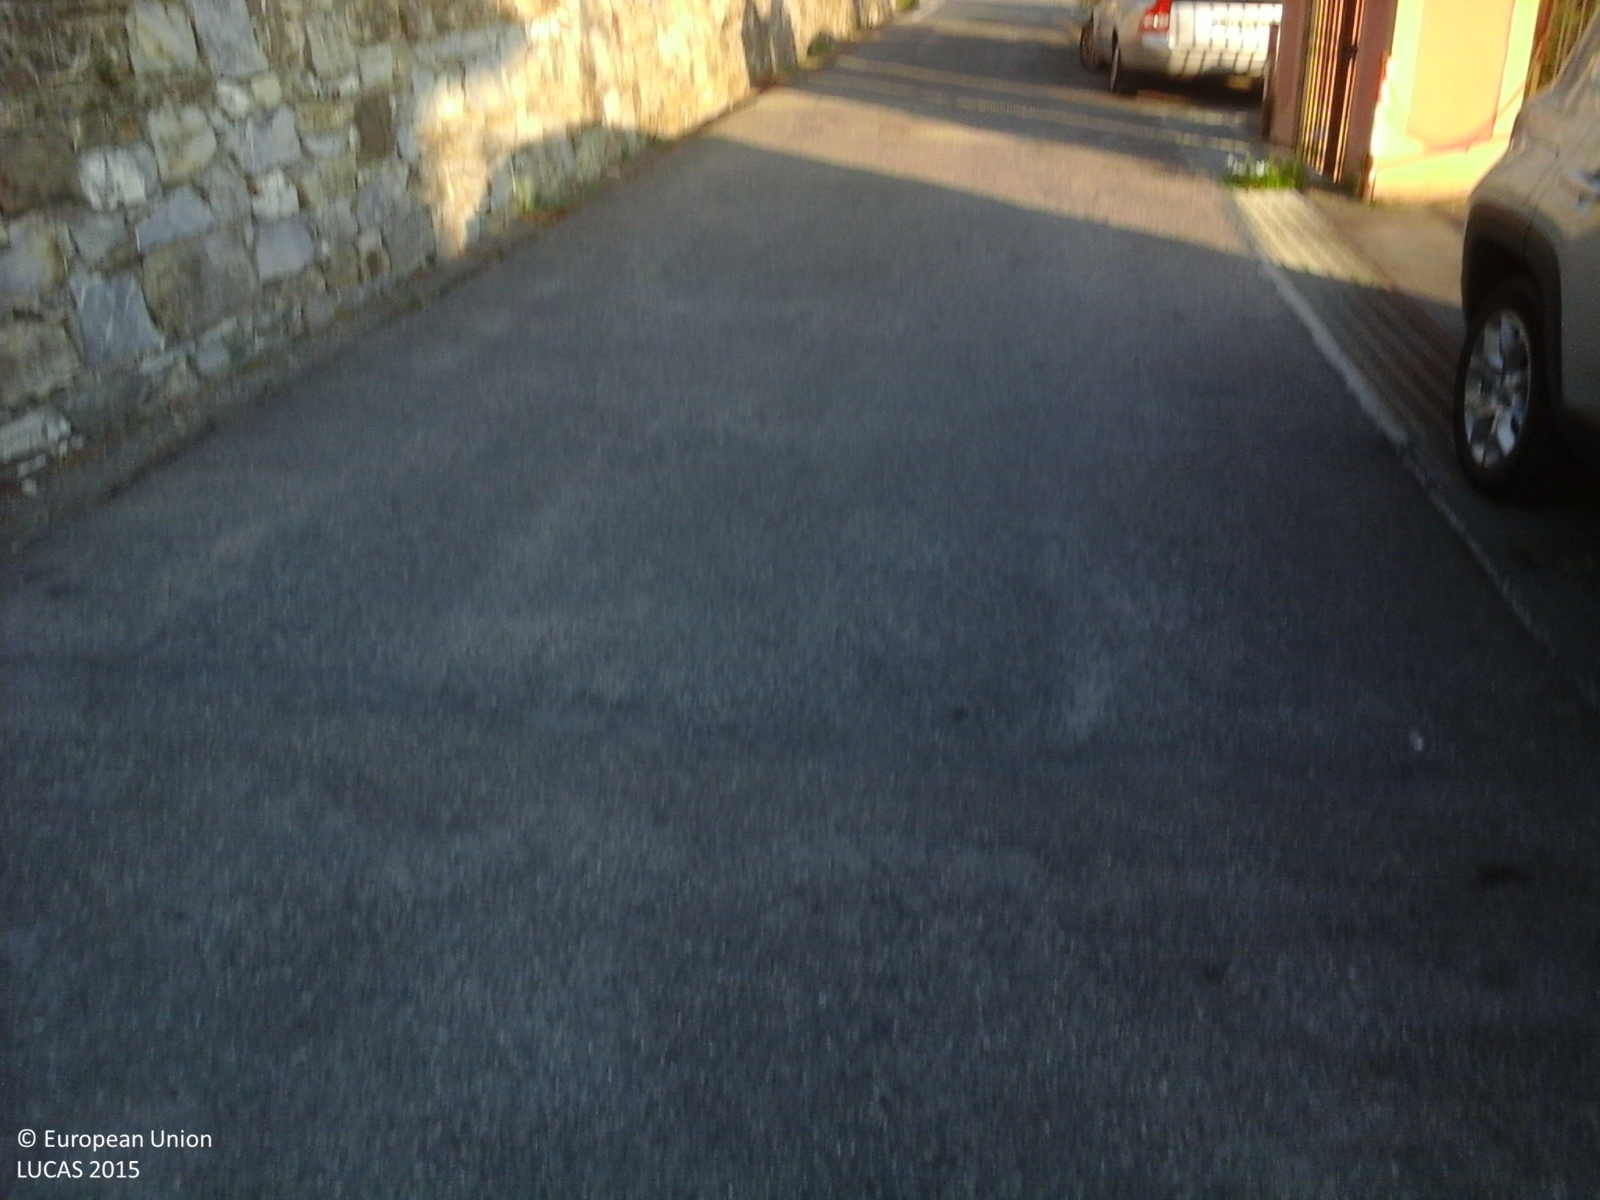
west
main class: Grassland
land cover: Grassland without tree/shrub cover
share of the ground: > 75 %
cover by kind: herbaceous plants 90 %, shrubs 5 %, consolidated bare surface 5 %
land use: Residential
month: August
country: IT
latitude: 44.3472
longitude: 9.1615
